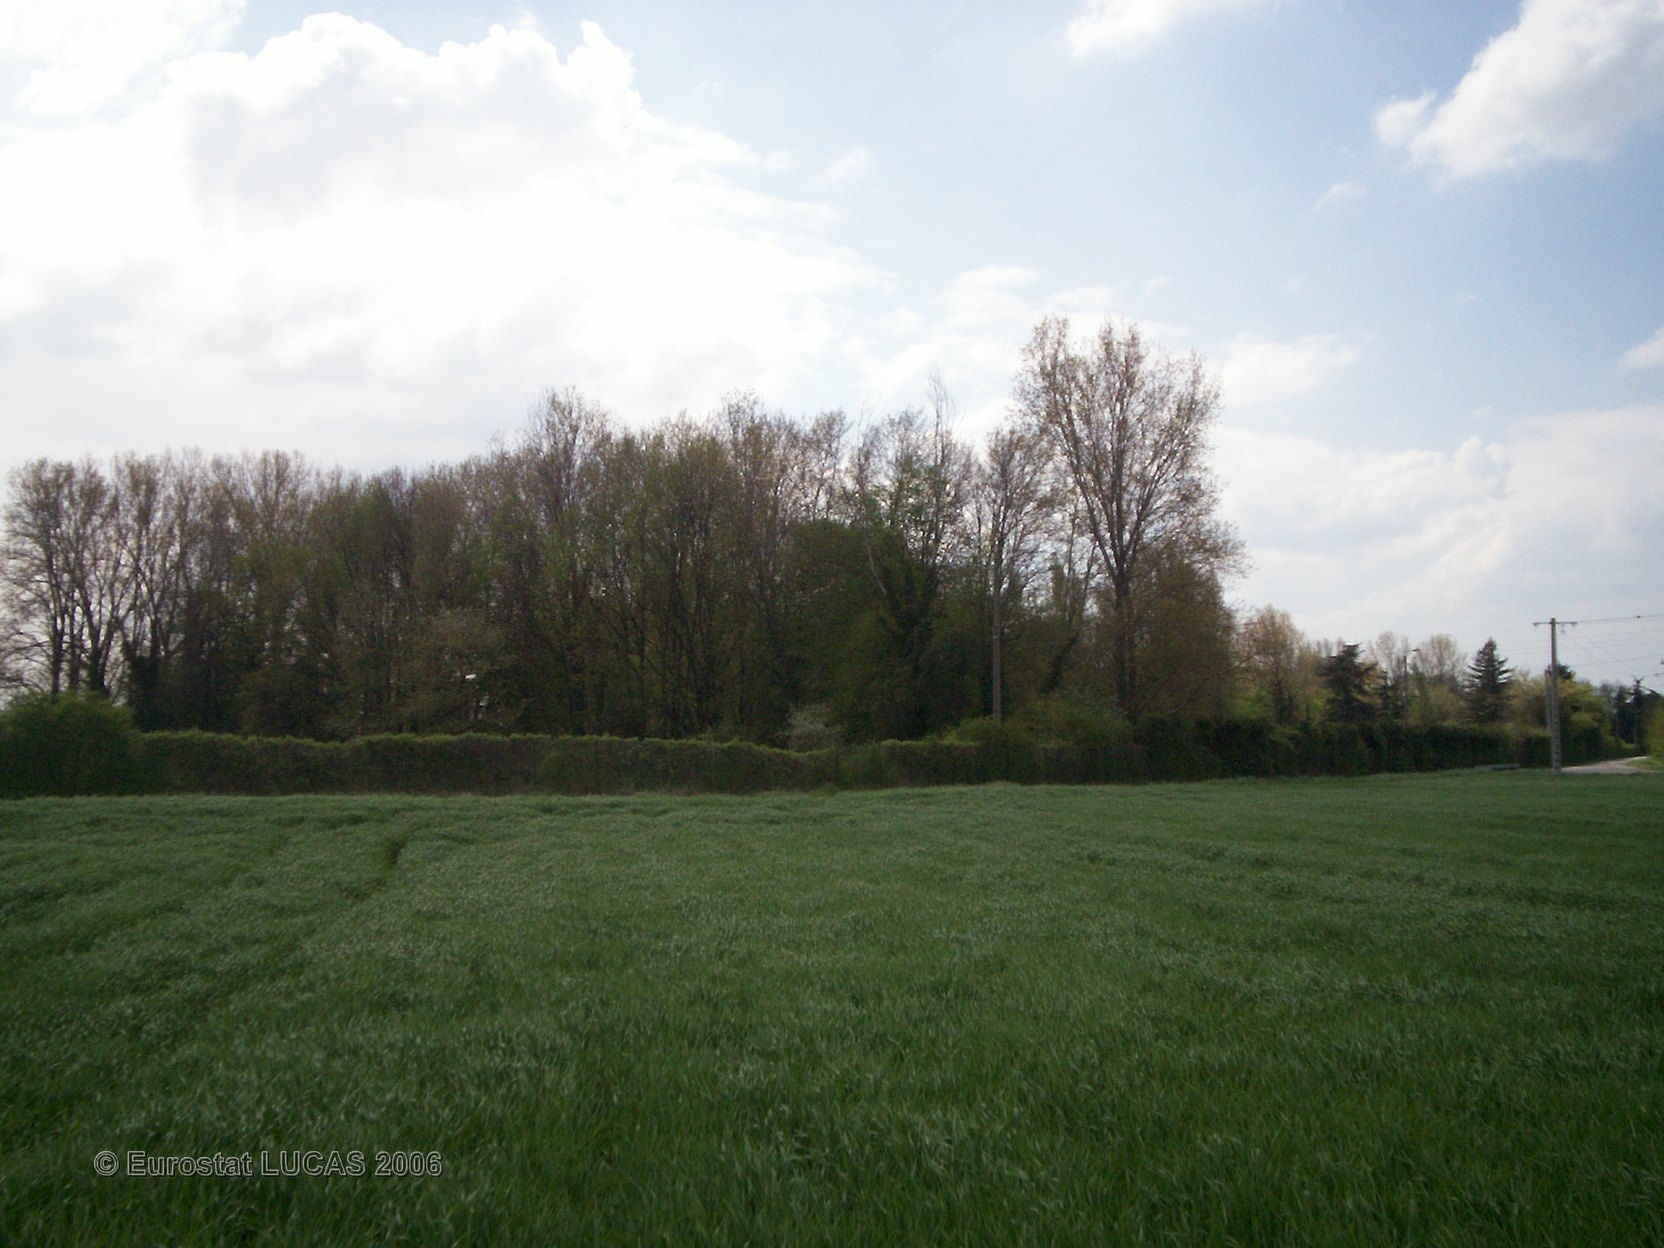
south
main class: Cropland
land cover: Barley
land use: Agriculture (excluding fallow land and kitchen gardens)
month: April
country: FR
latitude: 44.9105
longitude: 4.8760
